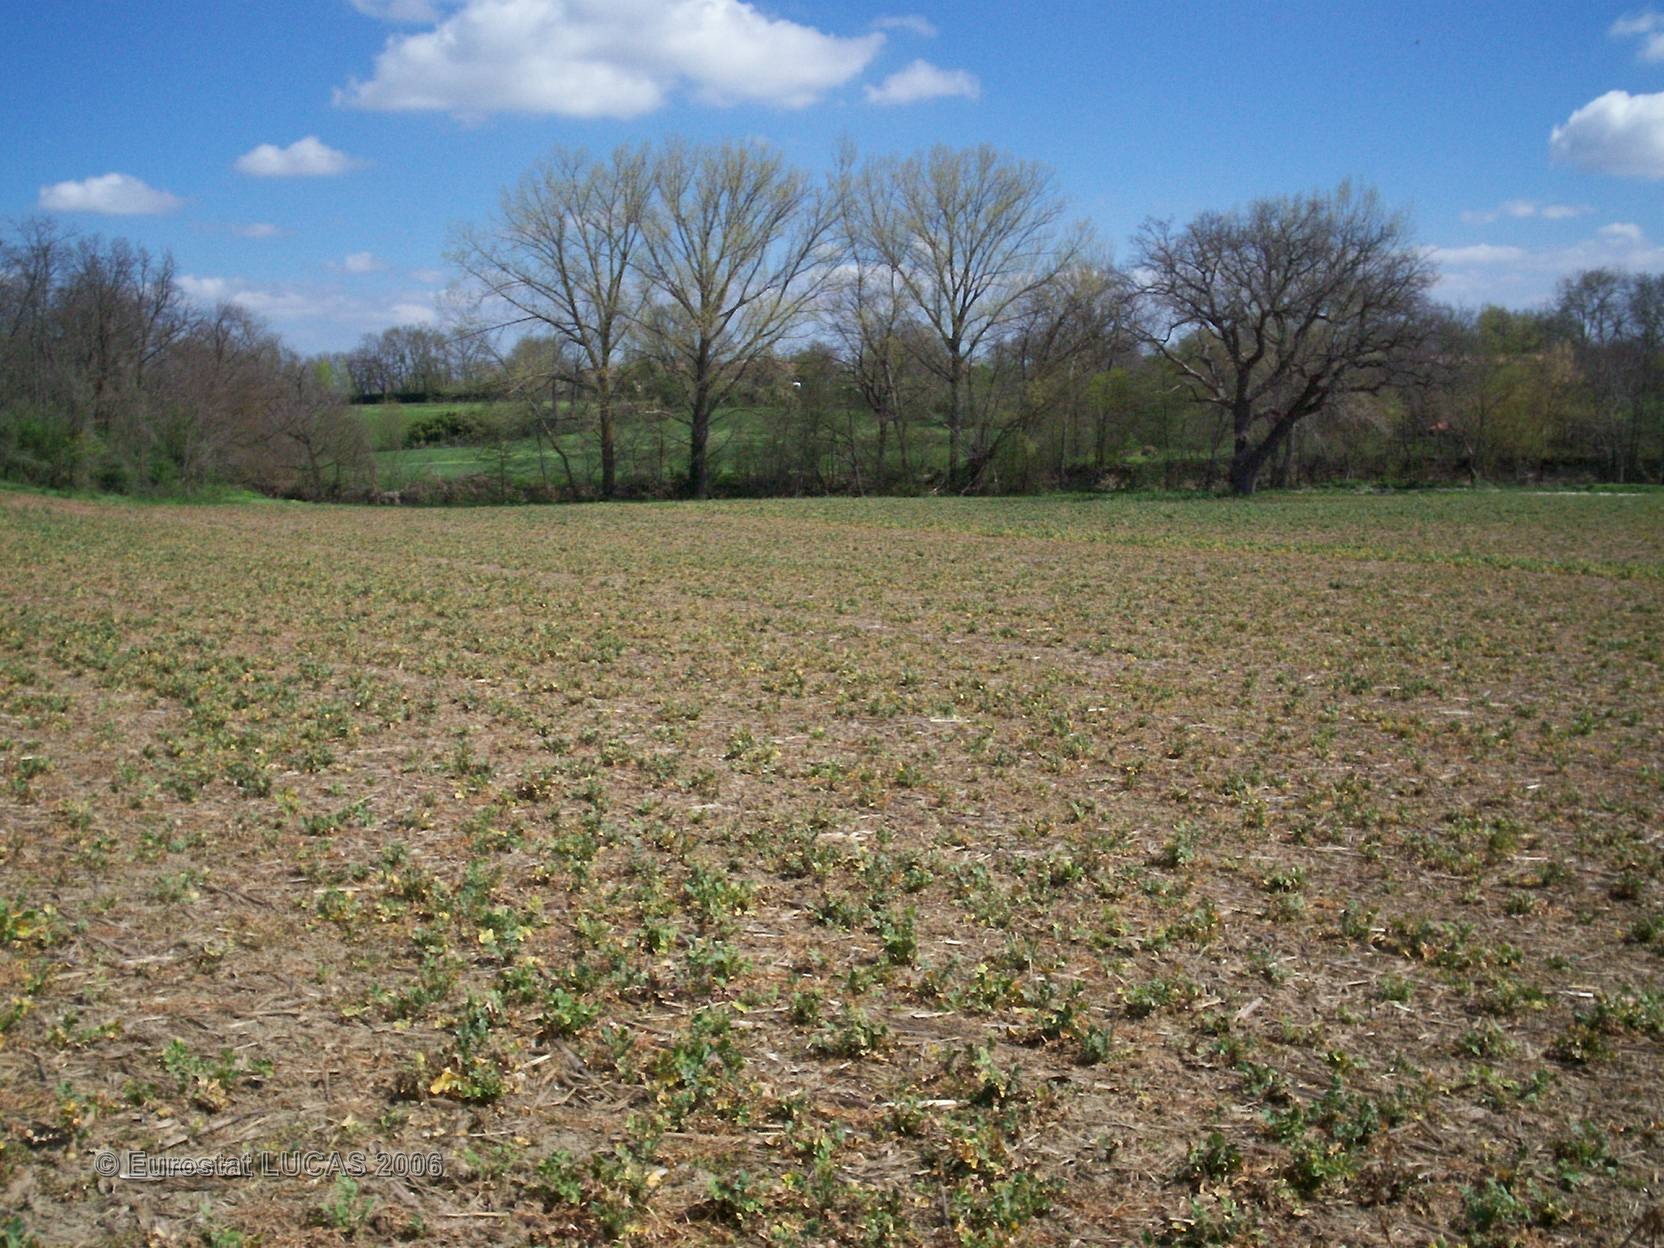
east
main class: Grassland
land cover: Grassland without tree/shrub cover
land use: Agriculture (excluding fallow land and kitchen gardens)
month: April
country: FR
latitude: 43.5556
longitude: 2.0457
